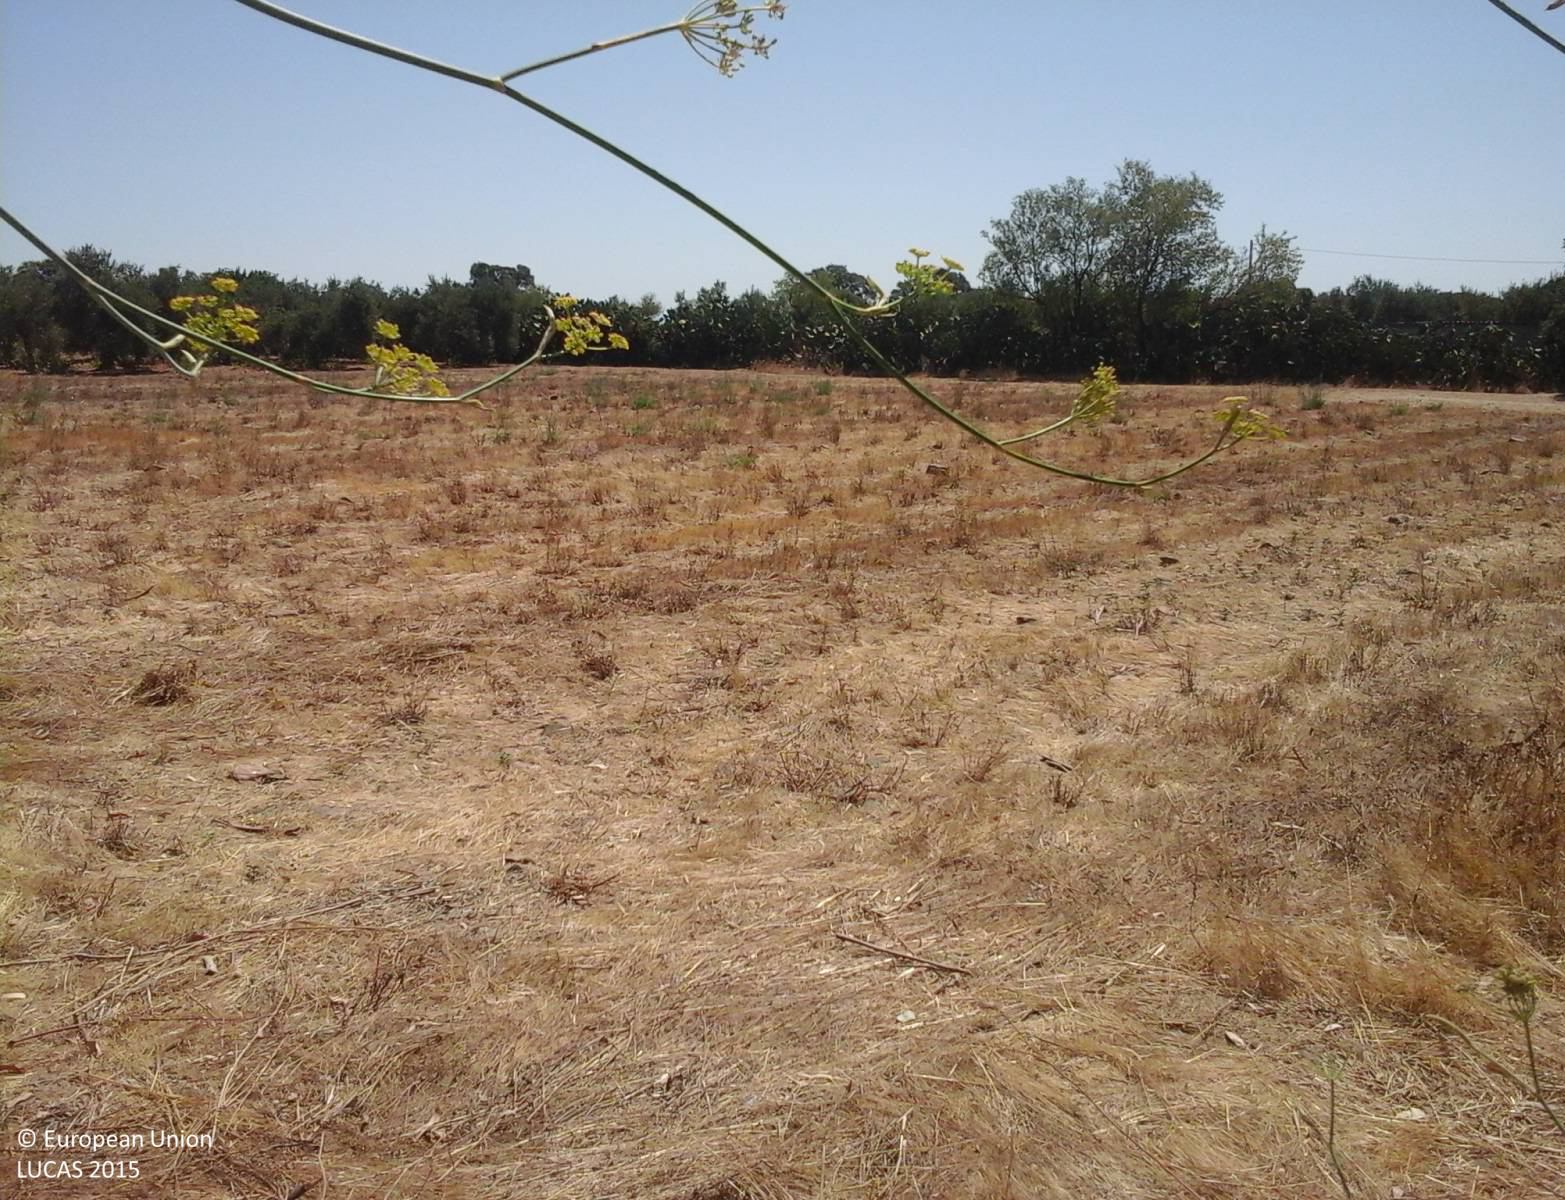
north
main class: Grassland
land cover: Grassland without tree/shrub cover
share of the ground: > 75 %
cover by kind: herbaceous plants 100 %
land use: Agriculture (excluding fallow land and kitchen gardens)
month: August
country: IT
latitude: 39.3723
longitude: 8.7885
